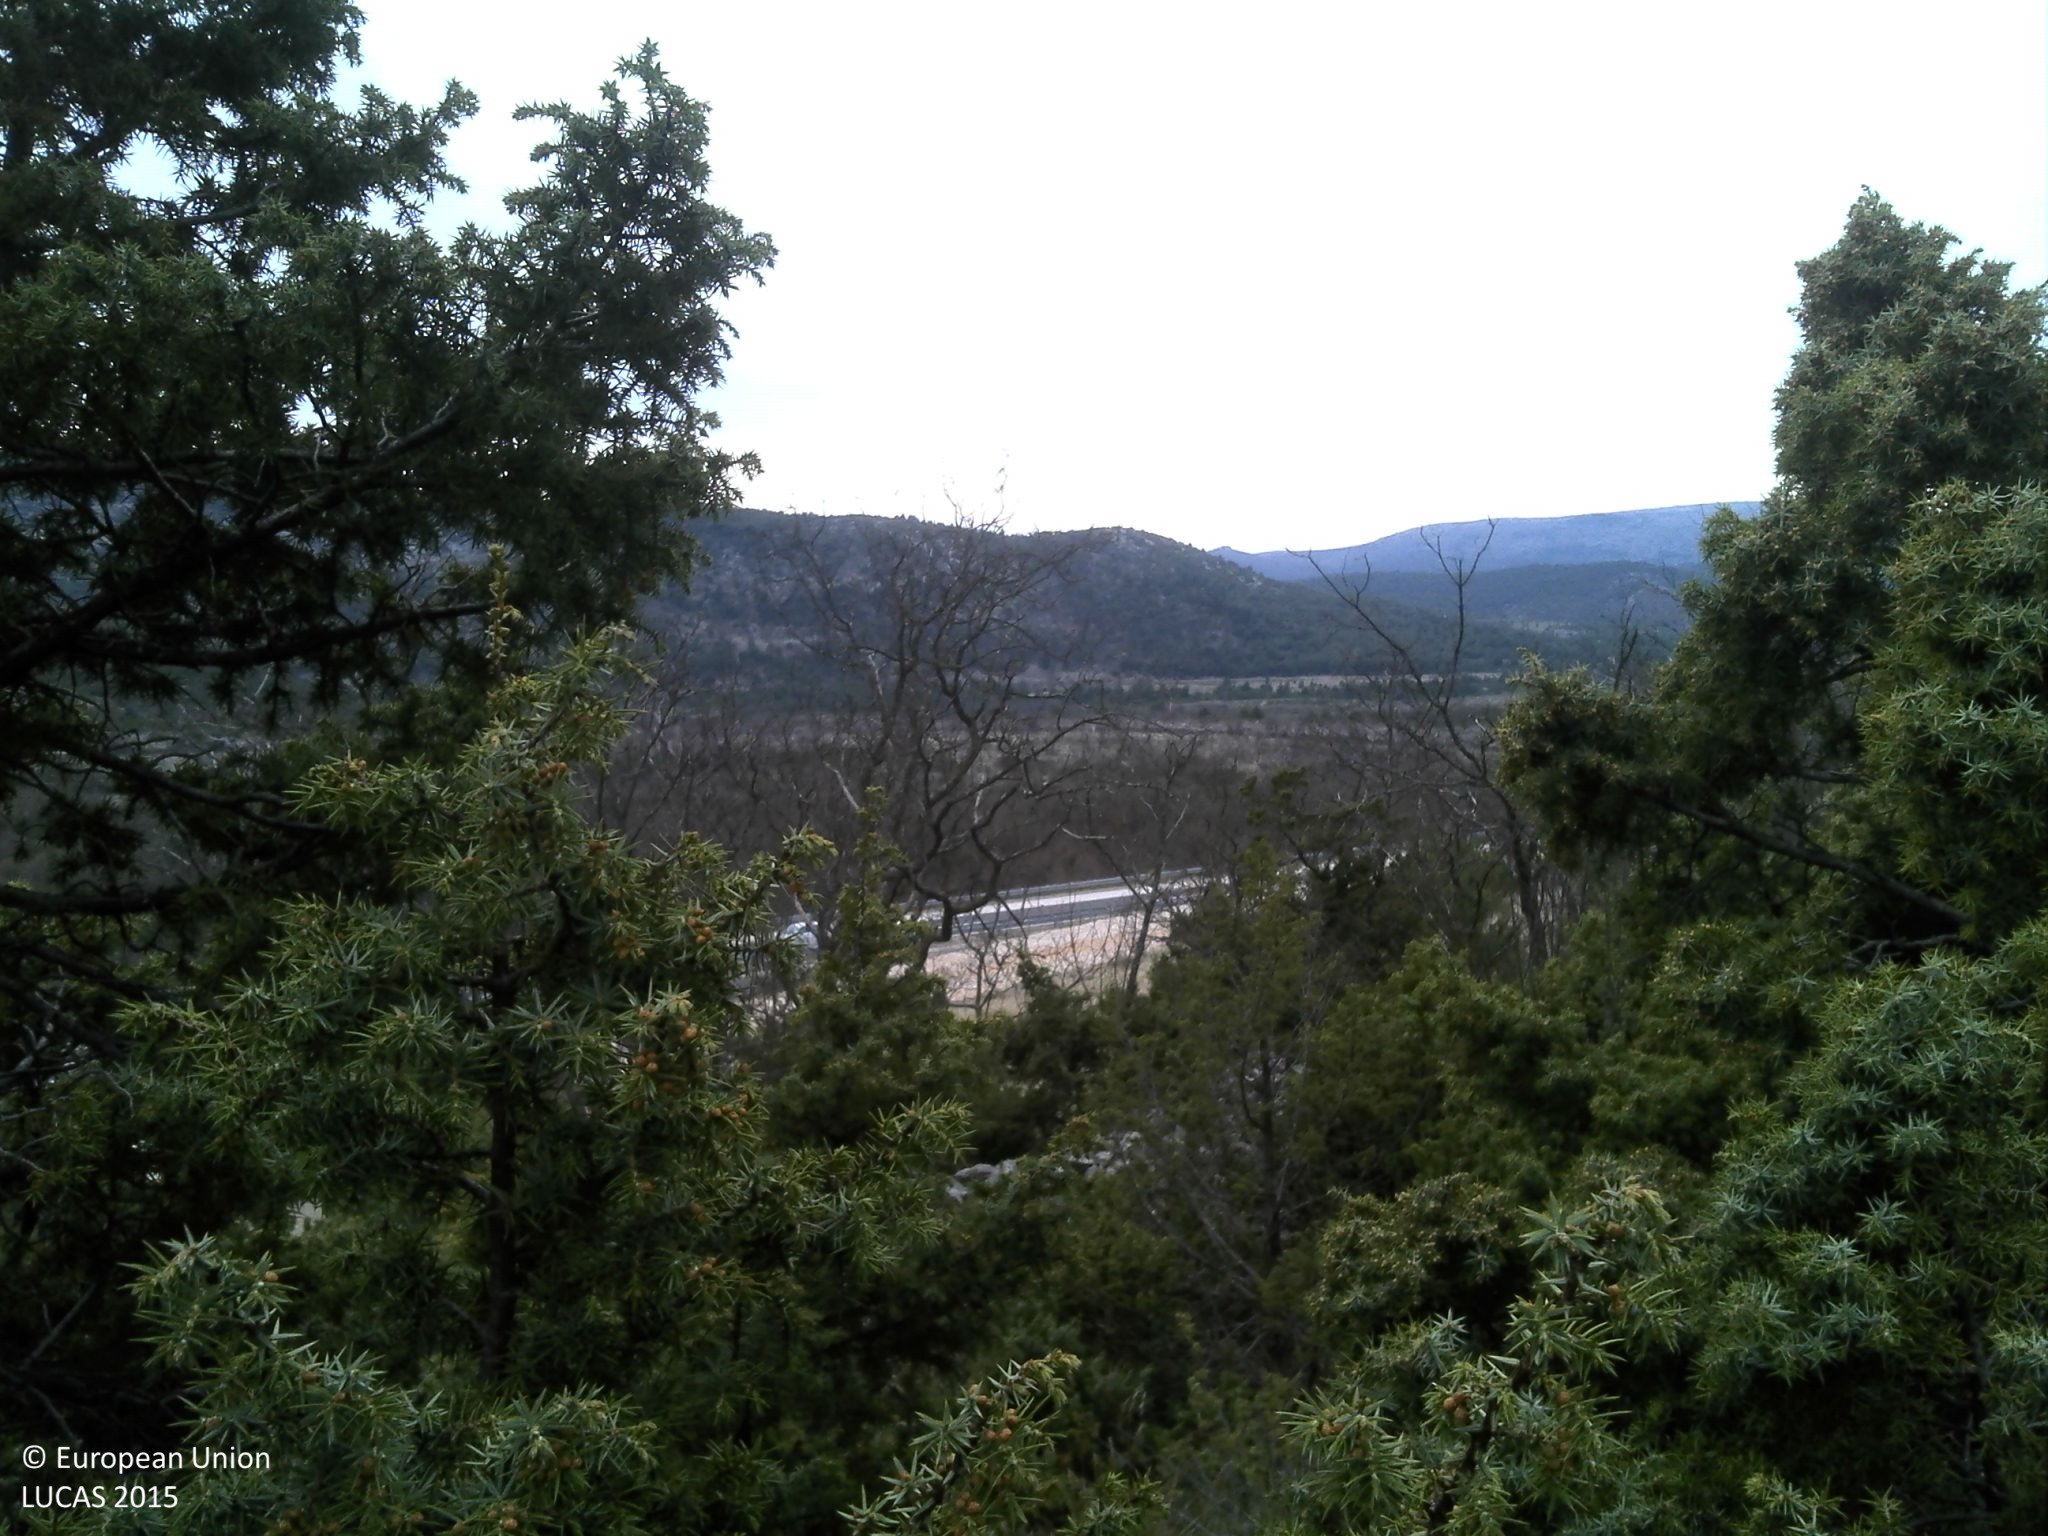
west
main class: Woodland
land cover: Other mixed woodland
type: coniferous forest of the mediterranean region
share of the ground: 50 - 75 %
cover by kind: coniferous forest trees 35 %, shrubs 25 %, broadleaved forest trees 15 %, consolidated bare surface 10 %, unconsolidated bare surface 10 %, herbaceous plants 5 %
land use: Semi-natural and natural areas not in use
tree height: < 5 m
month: April
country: HR
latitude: 43.6838
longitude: 16.0820
